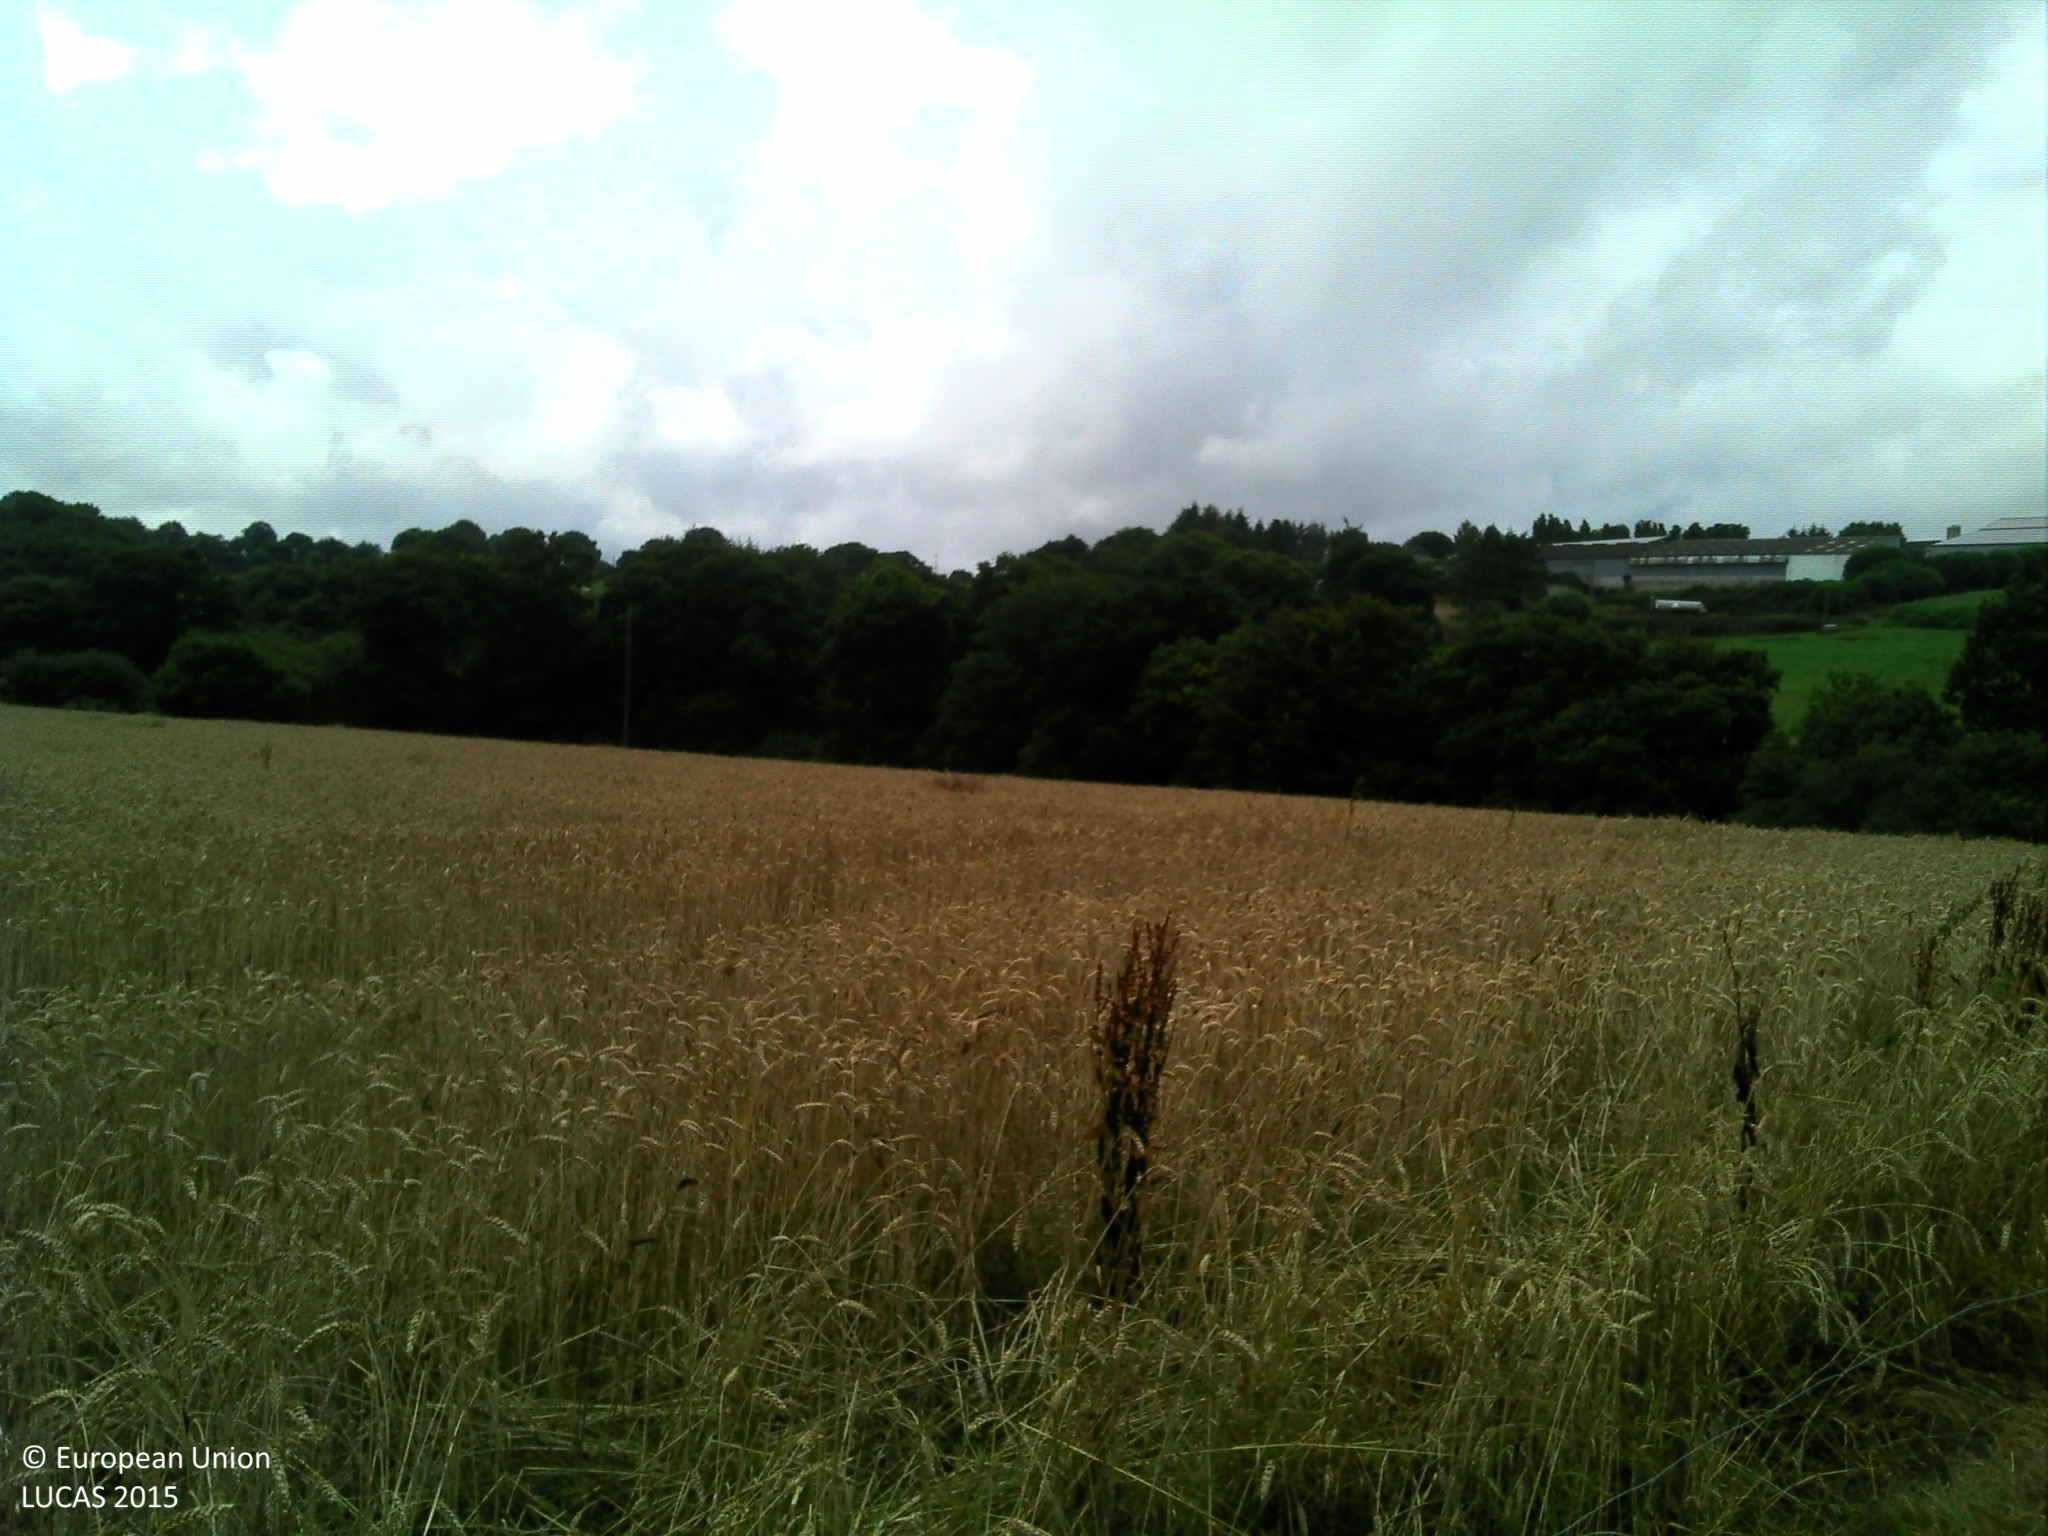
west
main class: Grassland
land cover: Grassland without tree/shrub cover
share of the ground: > 75 %
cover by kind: herbaceous plants 100 %
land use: Agriculture (excluding fallow land and kitchen gardens)
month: August
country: FR
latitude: 48.3789
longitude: -3.1552
